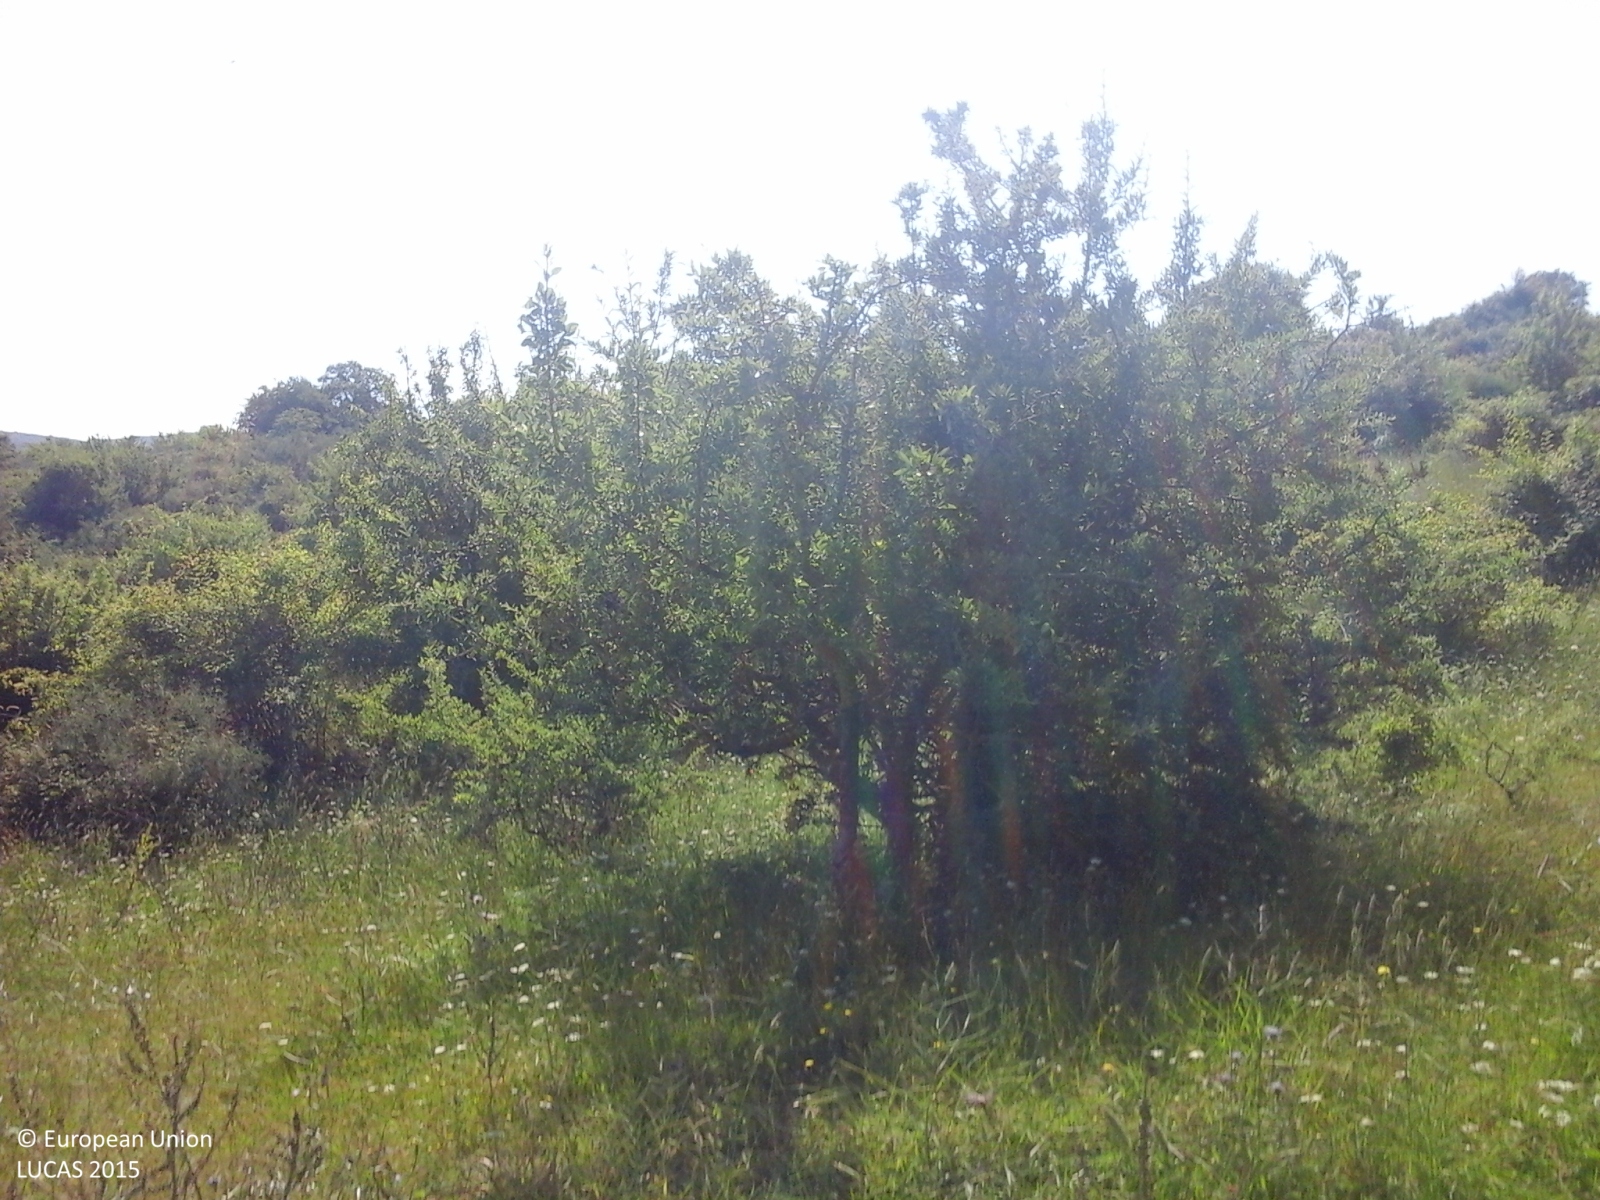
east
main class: Grassland
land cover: Grassland with sparse tree/shrub cover
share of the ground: > 75 %
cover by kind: herbaceous plants 85 %, shrubs 10 %, broadleaved forest trees 5 %
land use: Agriculture (excluding fallow land and kitchen gardens)
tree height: < 5 m
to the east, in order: Grassland with sparse tree/shrub cover; Shrubland with sparse tree cover; Ditches and canals; Shrubland with sparse tree cover; Spontaneously vegetated surfaces; Shrubland with sparse tree cover; Grassland with sparse tree/shrub cover
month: June
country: IT
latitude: 37.9086
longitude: 14.2130
